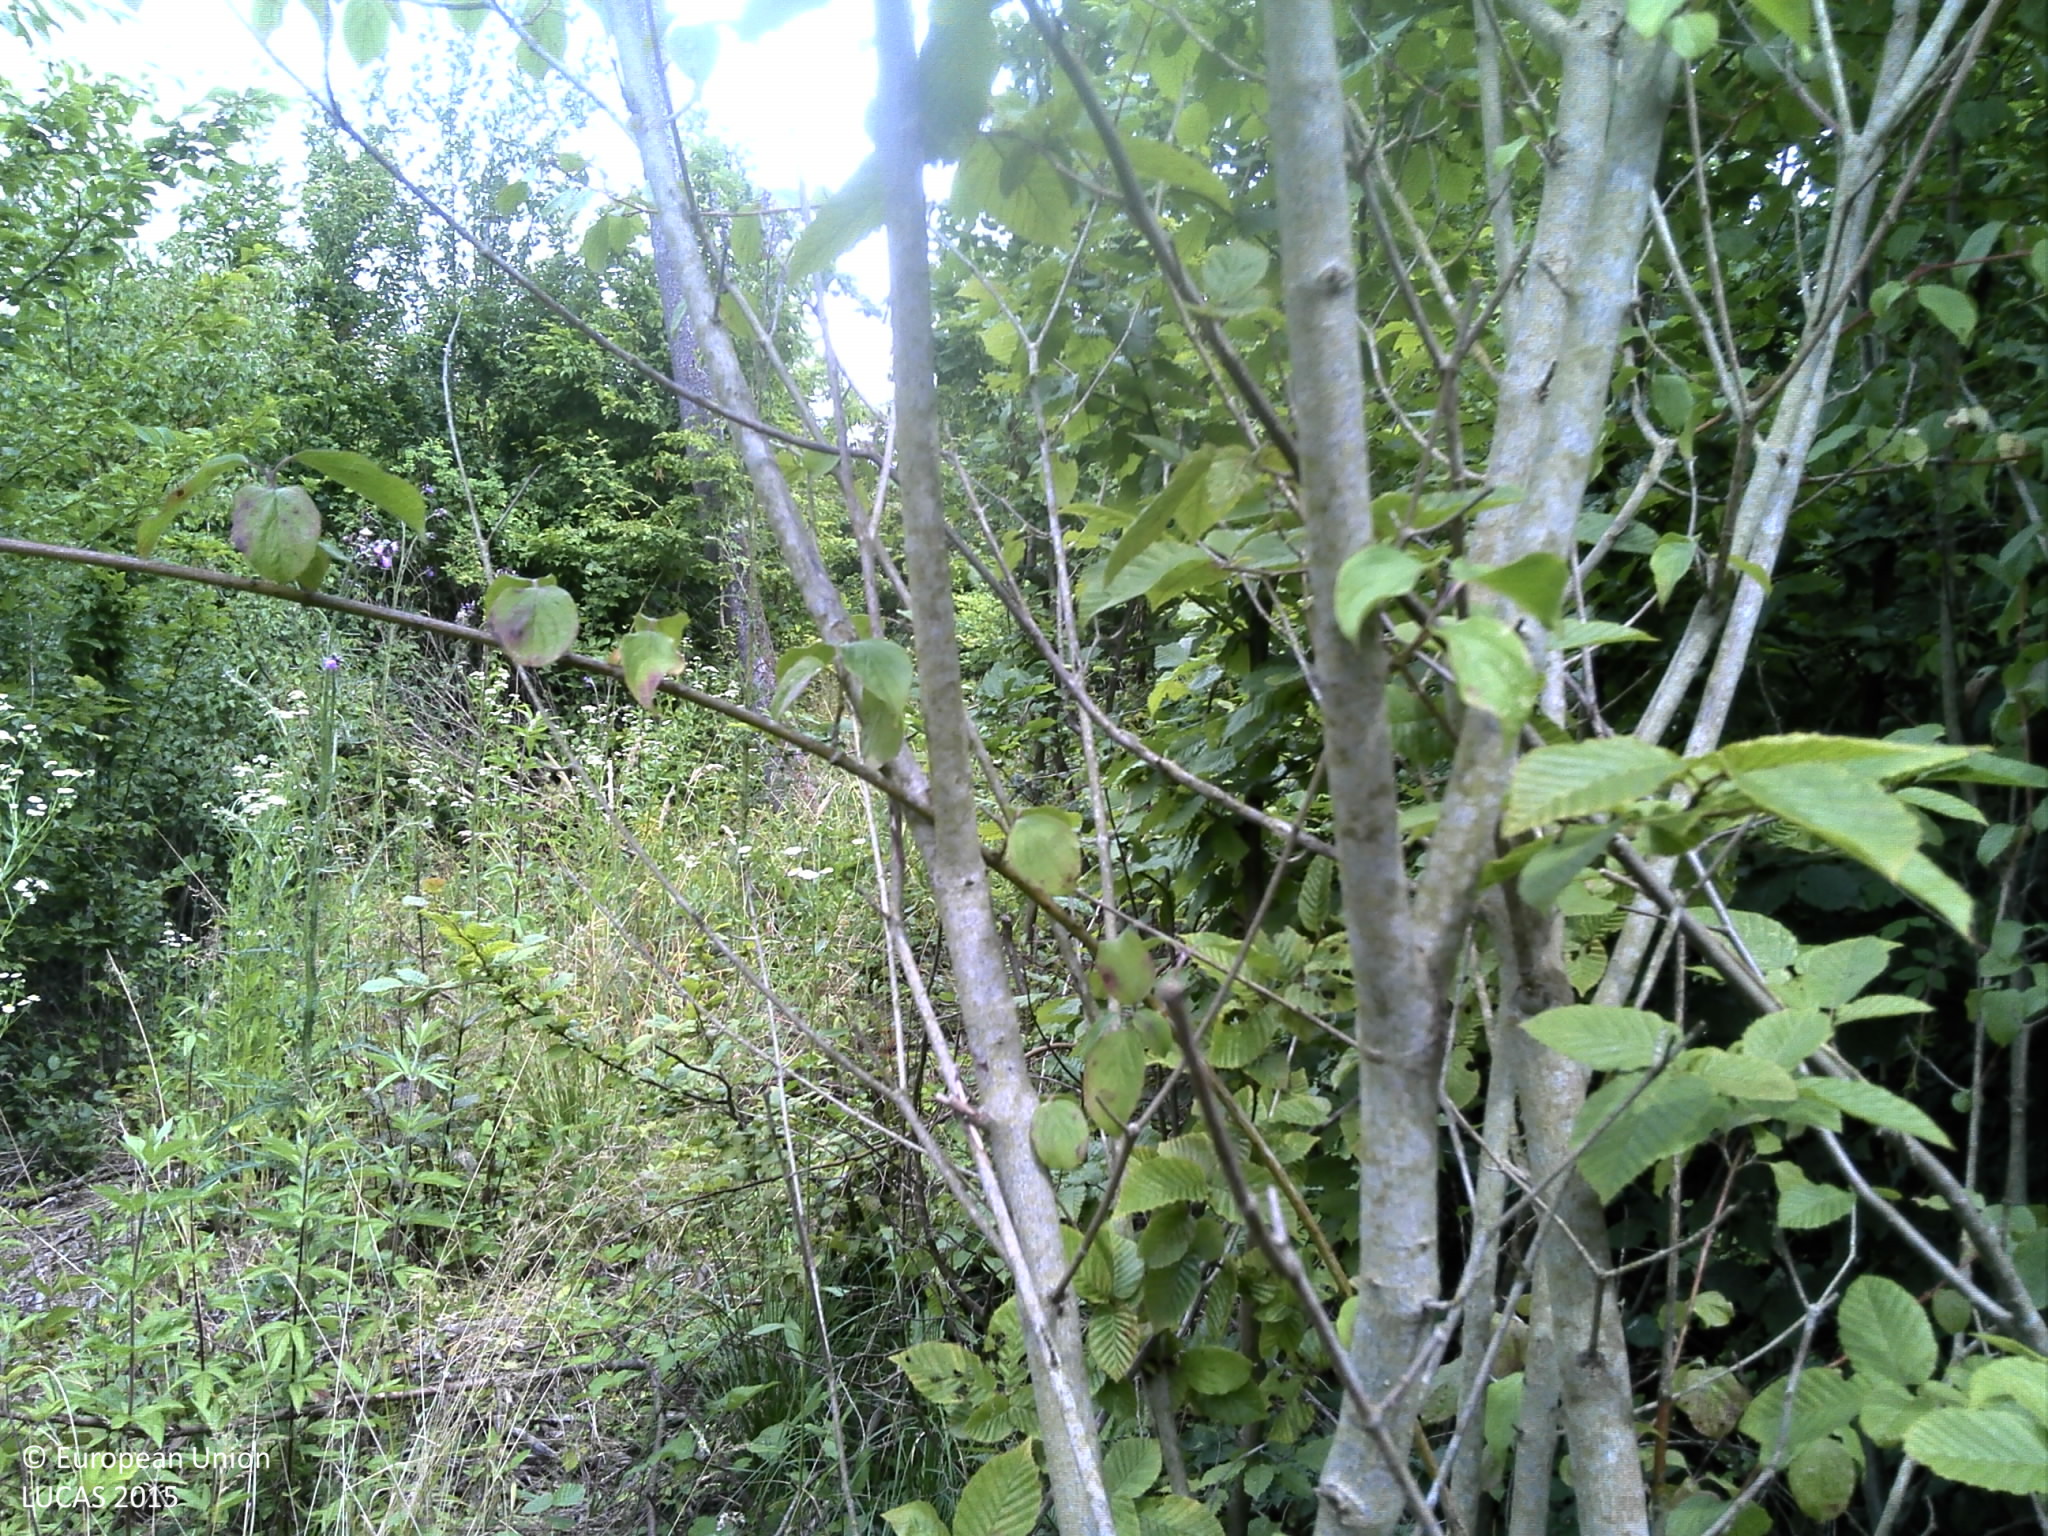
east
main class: Woodland
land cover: Broadleaved woodland
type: mesophytic deciduous forest
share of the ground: > 75 %
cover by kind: broadleaved forest trees 70 %, herbaceous plants 30 %
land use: Forestry
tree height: > 5 m
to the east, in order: Broadleaved woodland; Grass margins; Broadleaved woodland; Grass margins; Broadleaved woodland; Grass margins; Tracks; Broadleaved woodland; Tracks; Broadleaved woodland; Grassland without tree/shrub cover; Broadleaved woodland; Grass margins; Broadleaved woodland; Grass margins; Broadleaved woodland
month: June
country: FR
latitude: 49.2754
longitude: 6.2198
